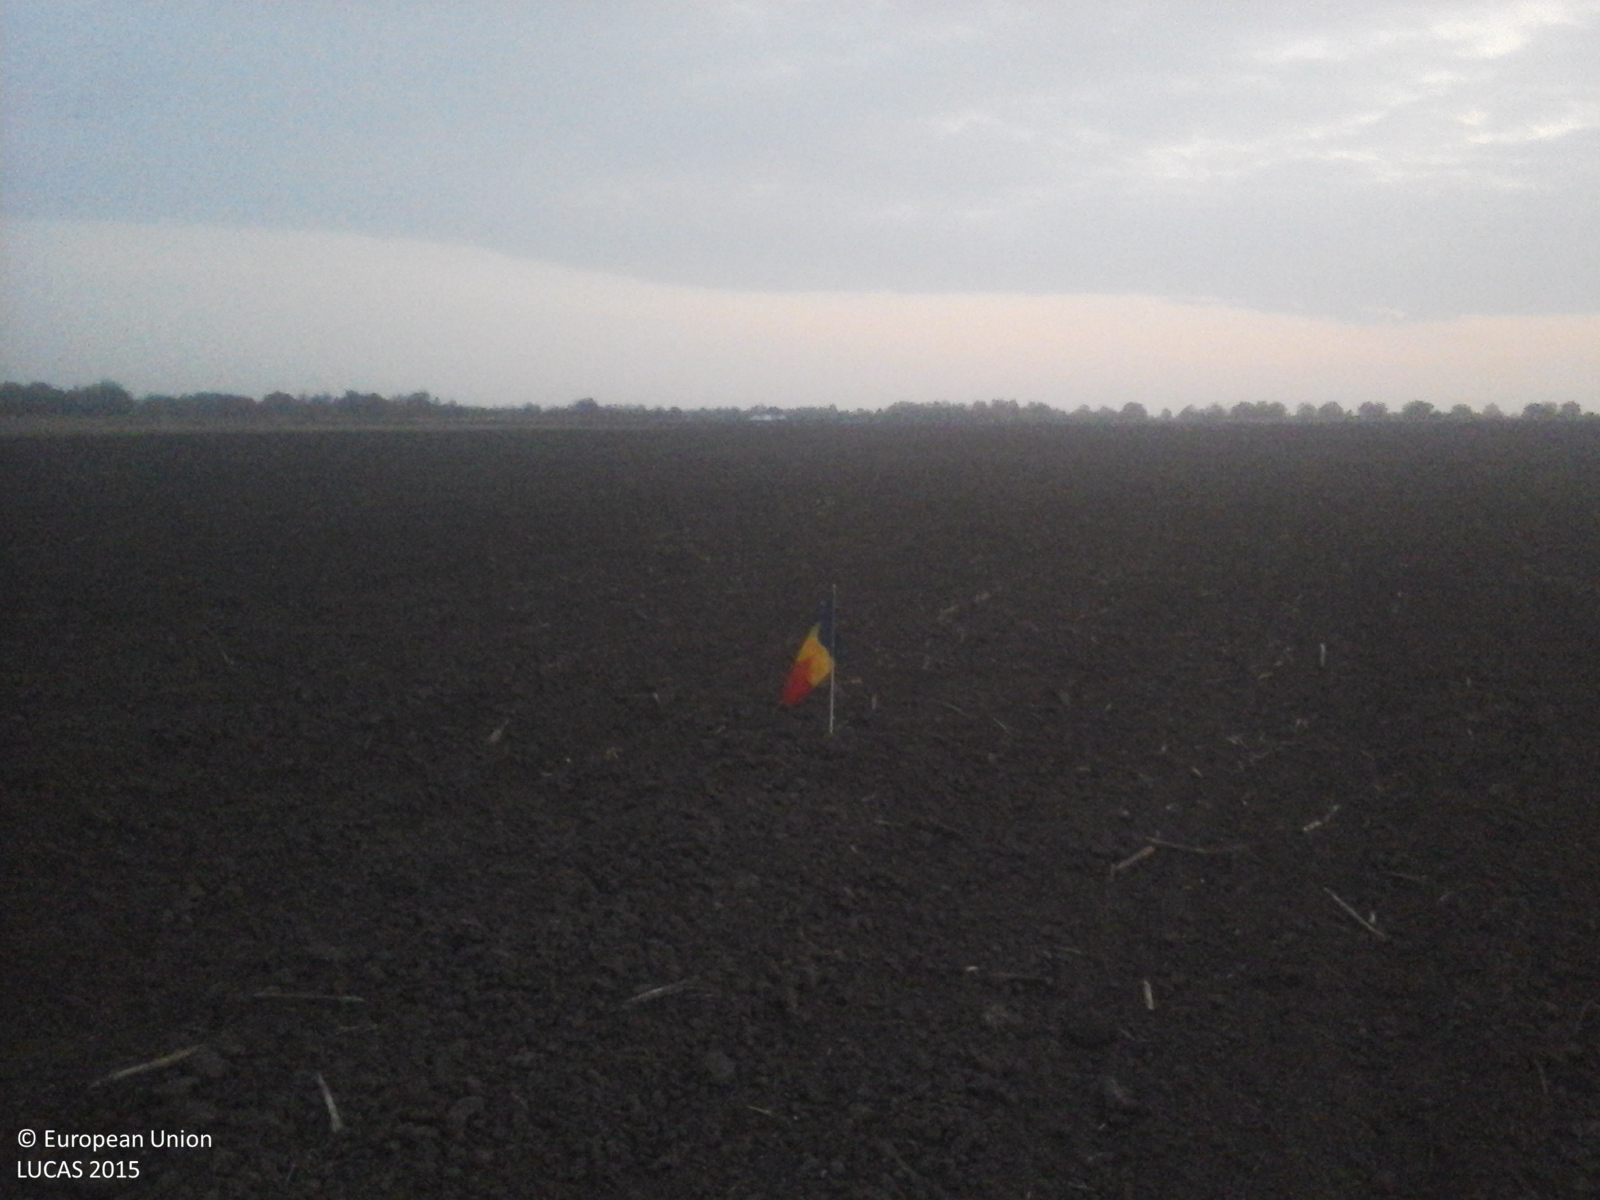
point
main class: Cropland
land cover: Maize
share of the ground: < 10 %
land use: Agriculture (excluding fallow land and kitchen gardens)
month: October
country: RO
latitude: 45.2892
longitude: 27.0057
